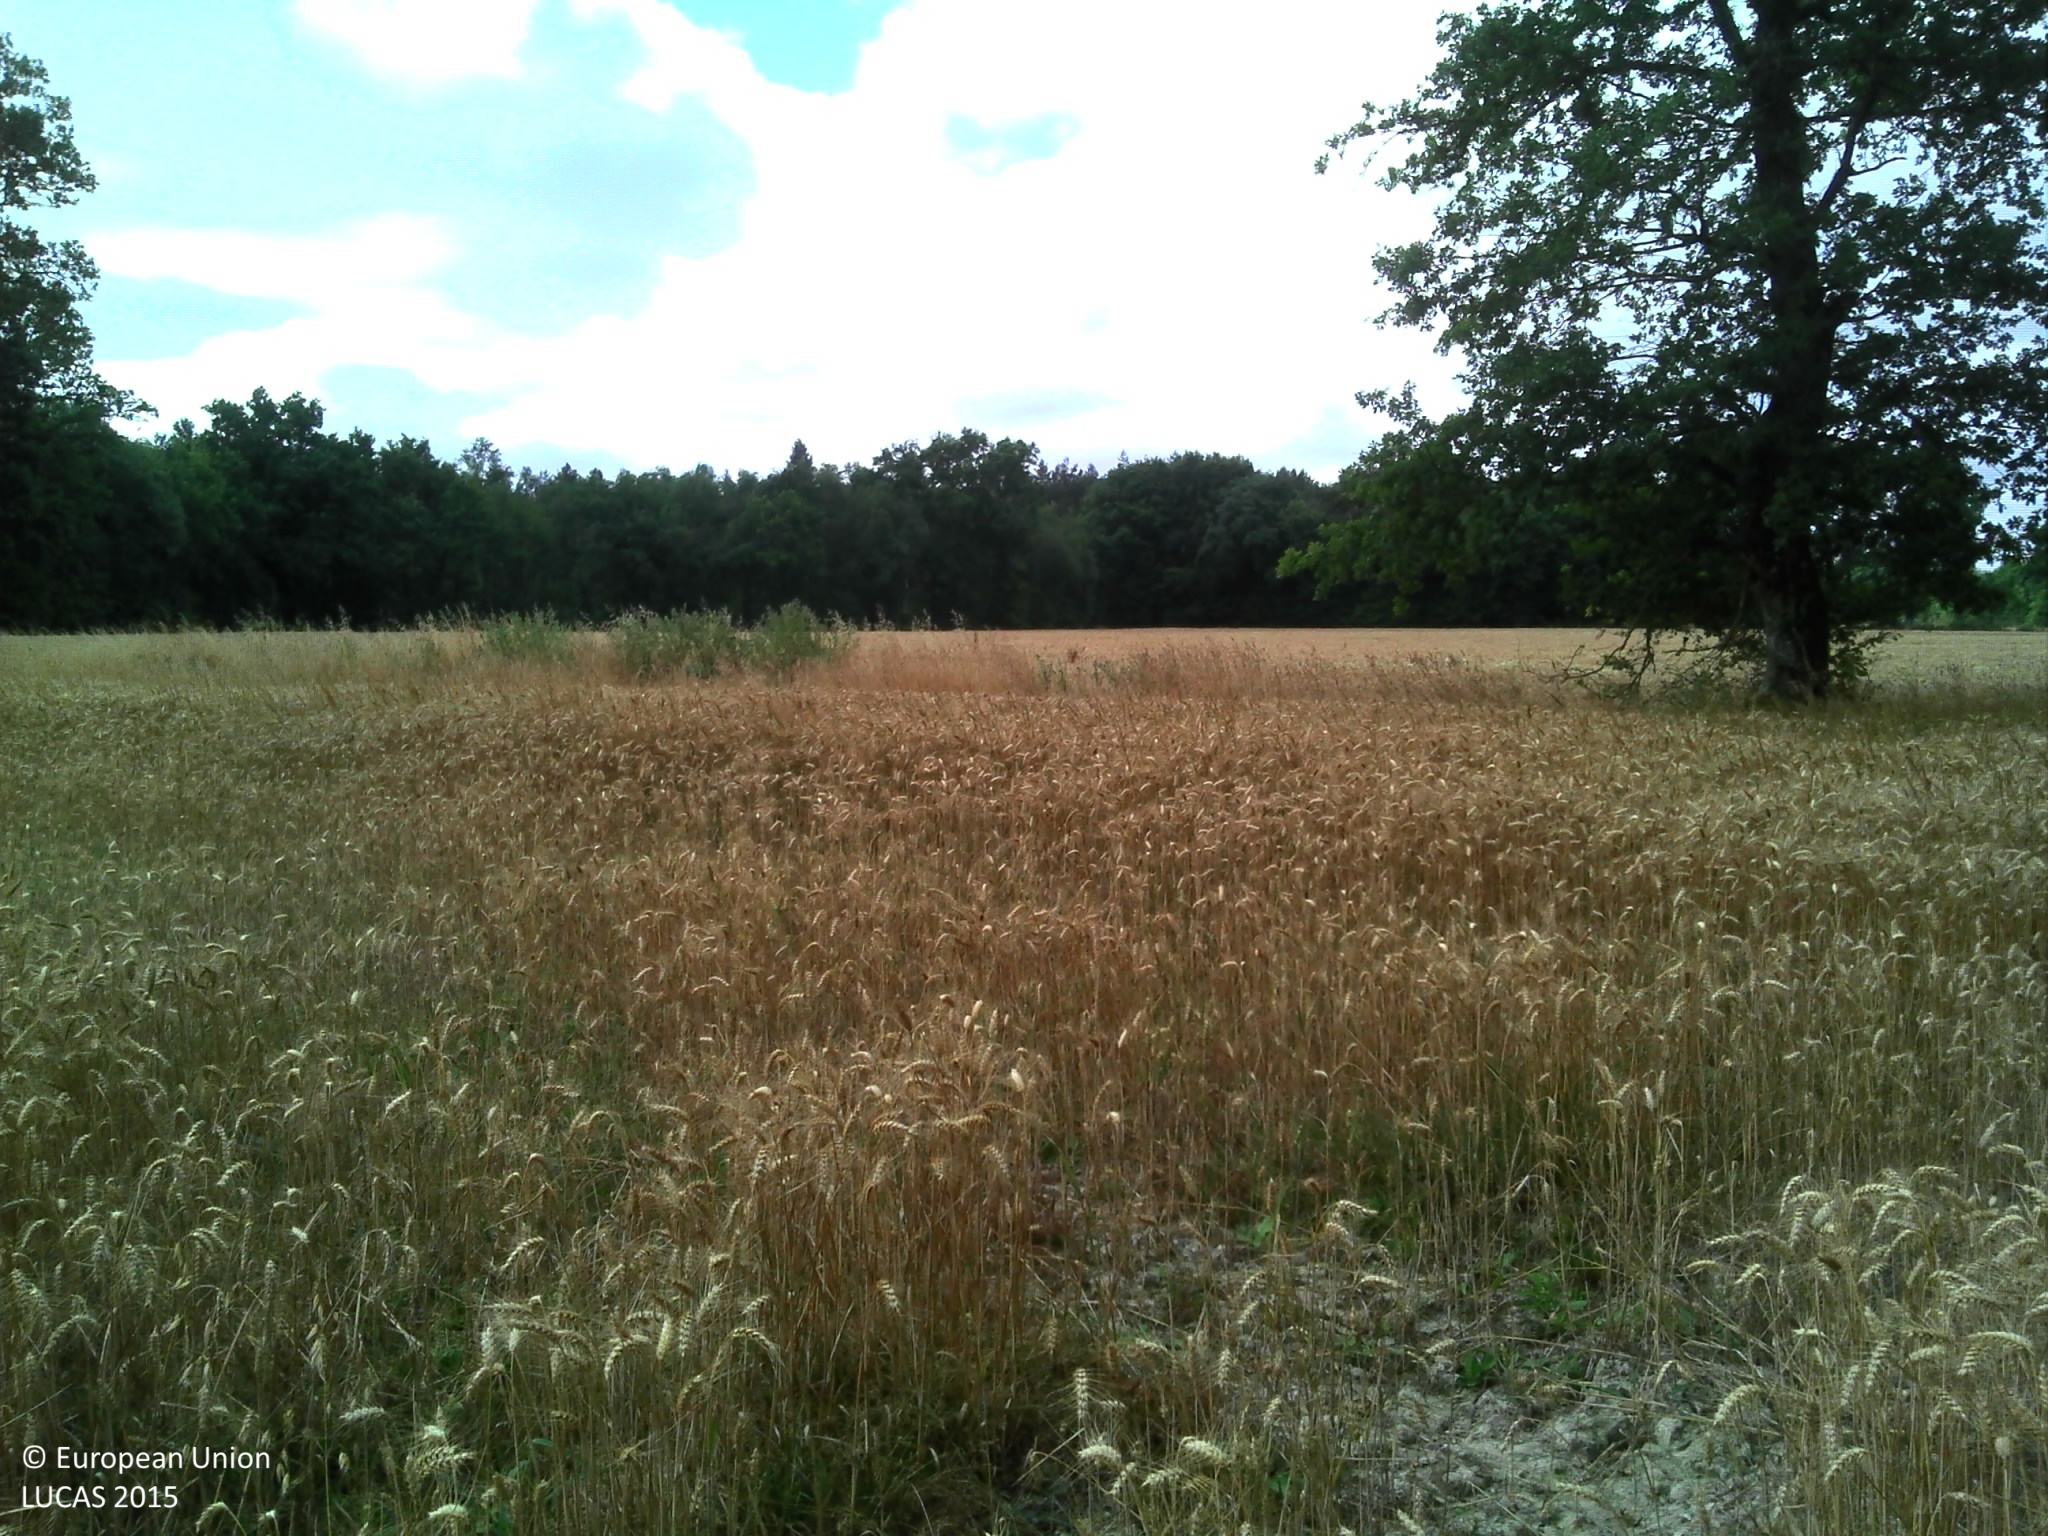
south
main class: Cropland
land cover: Common wheat
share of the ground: > 75 %
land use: Agriculture (excluding fallow land and kitchen gardens)
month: July
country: FR
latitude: 47.6096
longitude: -1.9286
